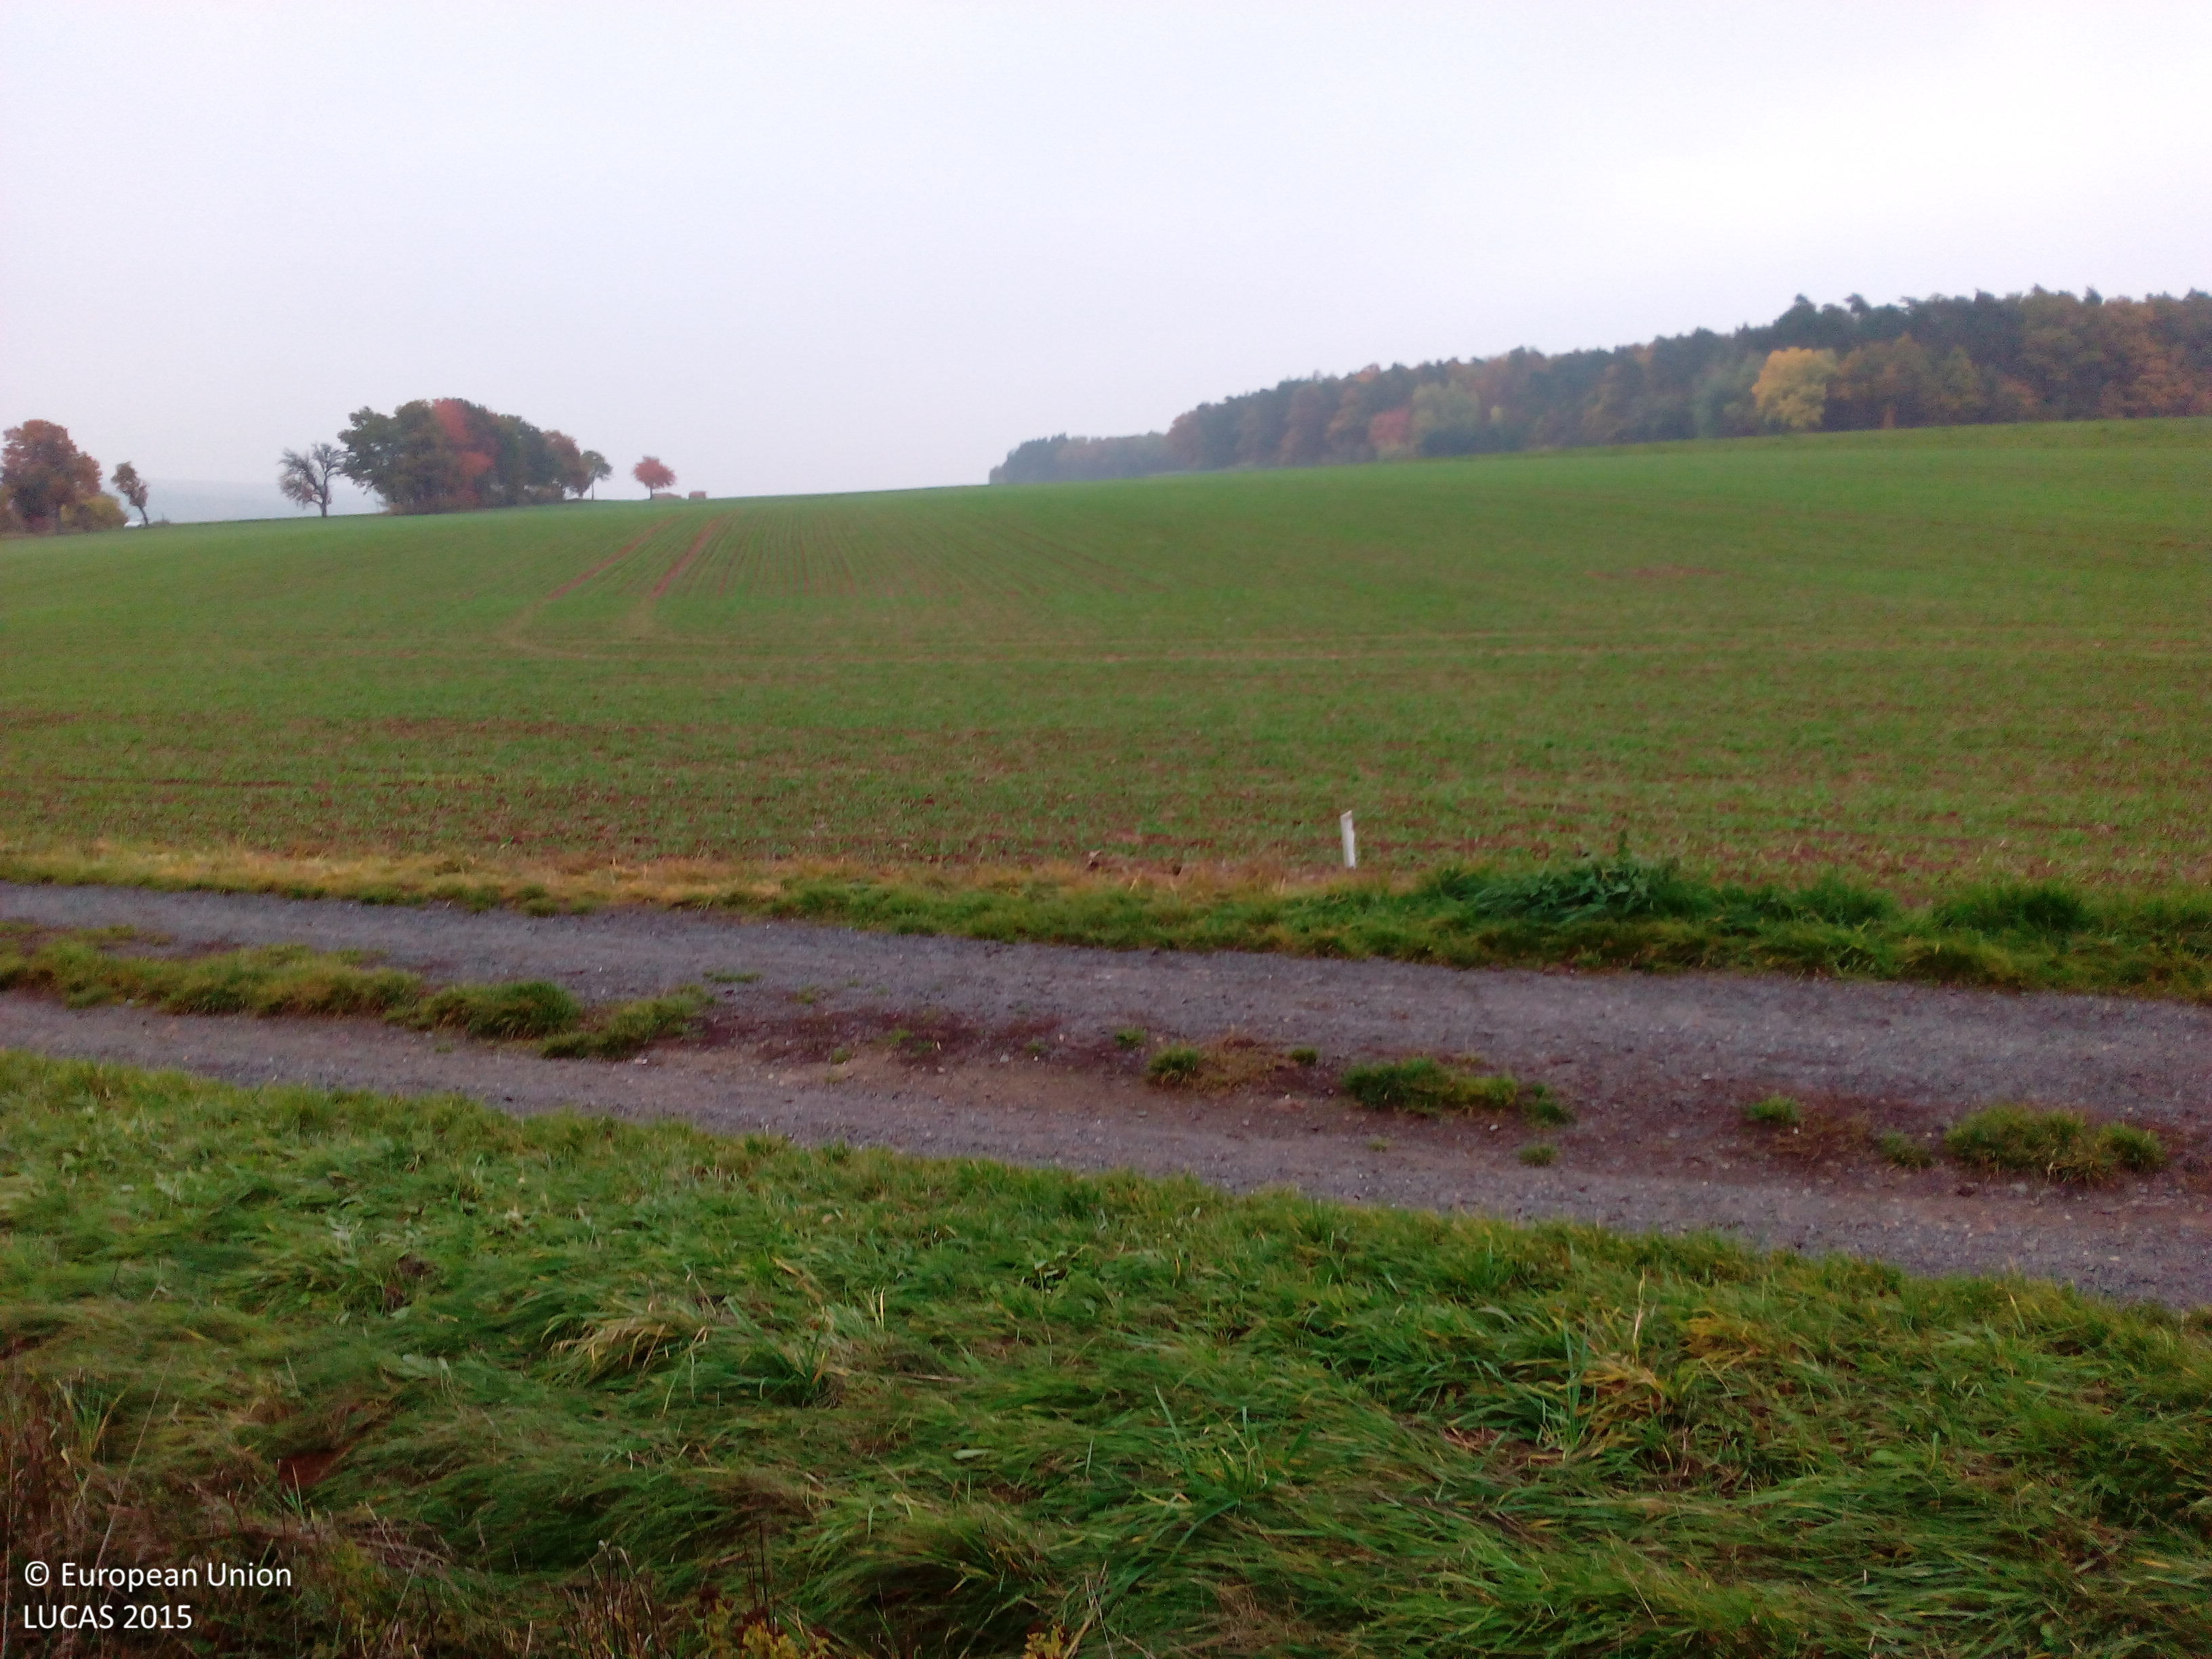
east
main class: Grassland
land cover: Grassland without tree/shrub cover
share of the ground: > 75 %
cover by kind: herbaceous plants 100 %
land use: Agriculture (excluding fallow land and kitchen gardens)
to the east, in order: Grassland without tree/shrub cover; Grass margins; Fences; Grass margins; Paved roads, cycling and walking lanes; Grass margins; Common wheat
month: October
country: DE
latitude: 50.1842
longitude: 9.8740
